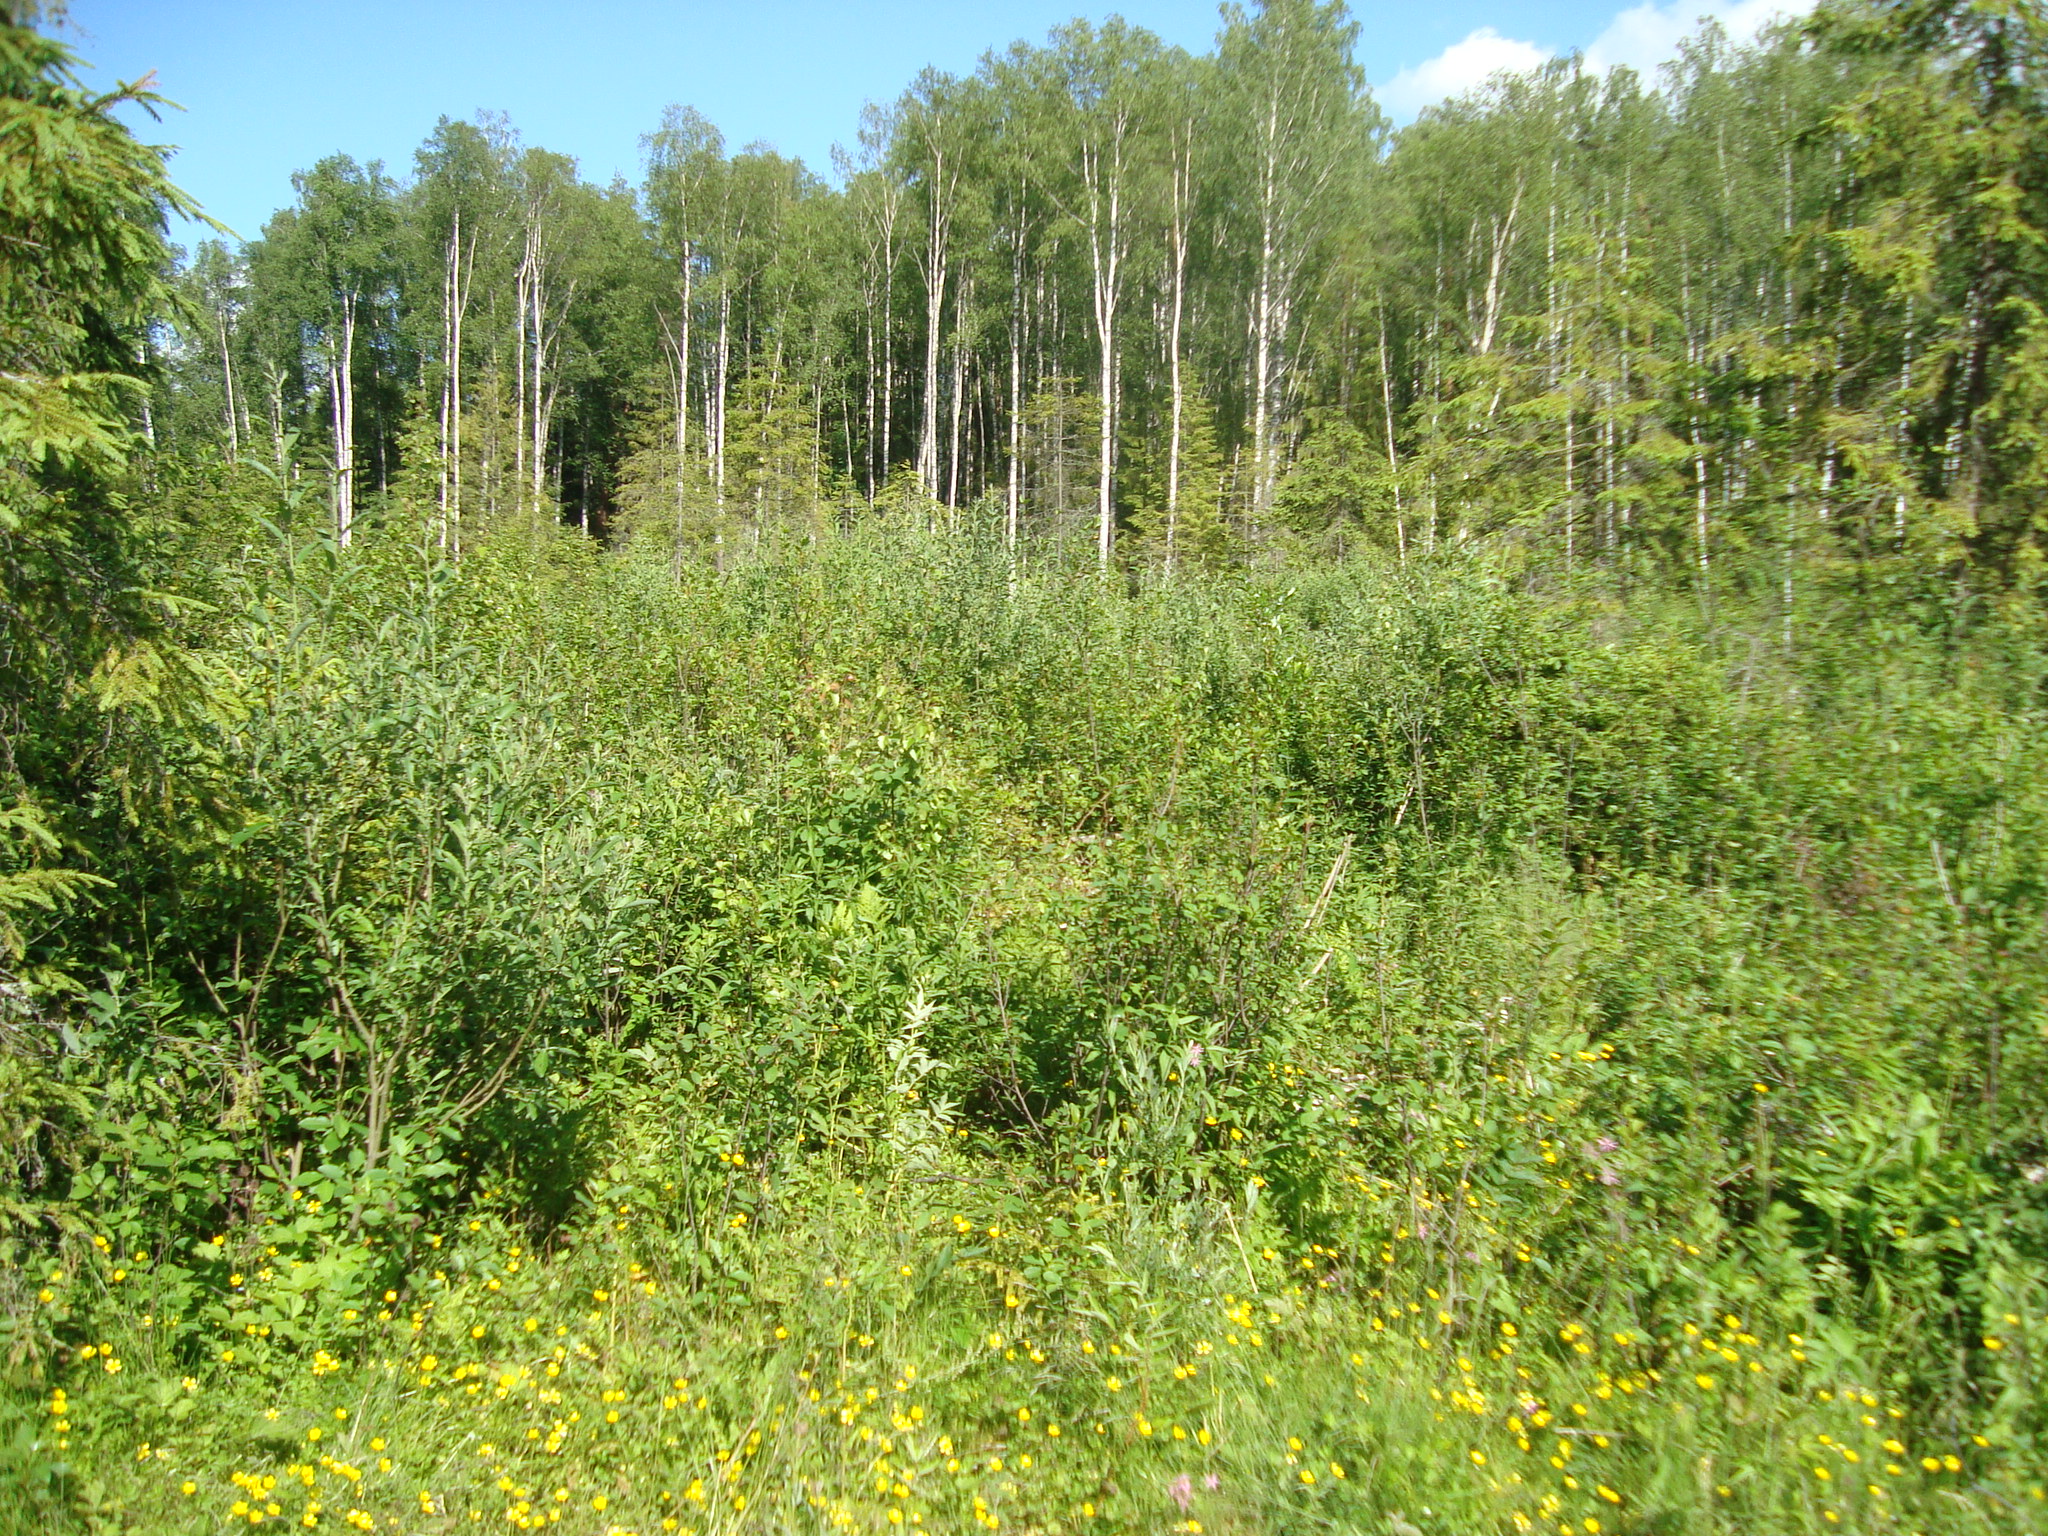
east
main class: Woodland
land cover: Spruce dominated mixed woodland
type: hemiboreal forest and nemoral coniferous forest and mixed broadleaved-coniferous forest
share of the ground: > 75 %
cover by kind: broadleaved forest trees 50 %, coniferous forest trees 30 %, shrubs 15 %, herbaceous plants 5 %
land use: Forestry
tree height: < 5 m
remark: Clear cut
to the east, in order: Spruce dominated mixed woodland; Broadleaved woodland; Spruce dominated coniferous woodland; Broadleaved woodland
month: June
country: LV
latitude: 56.6585
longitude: 25.7377
